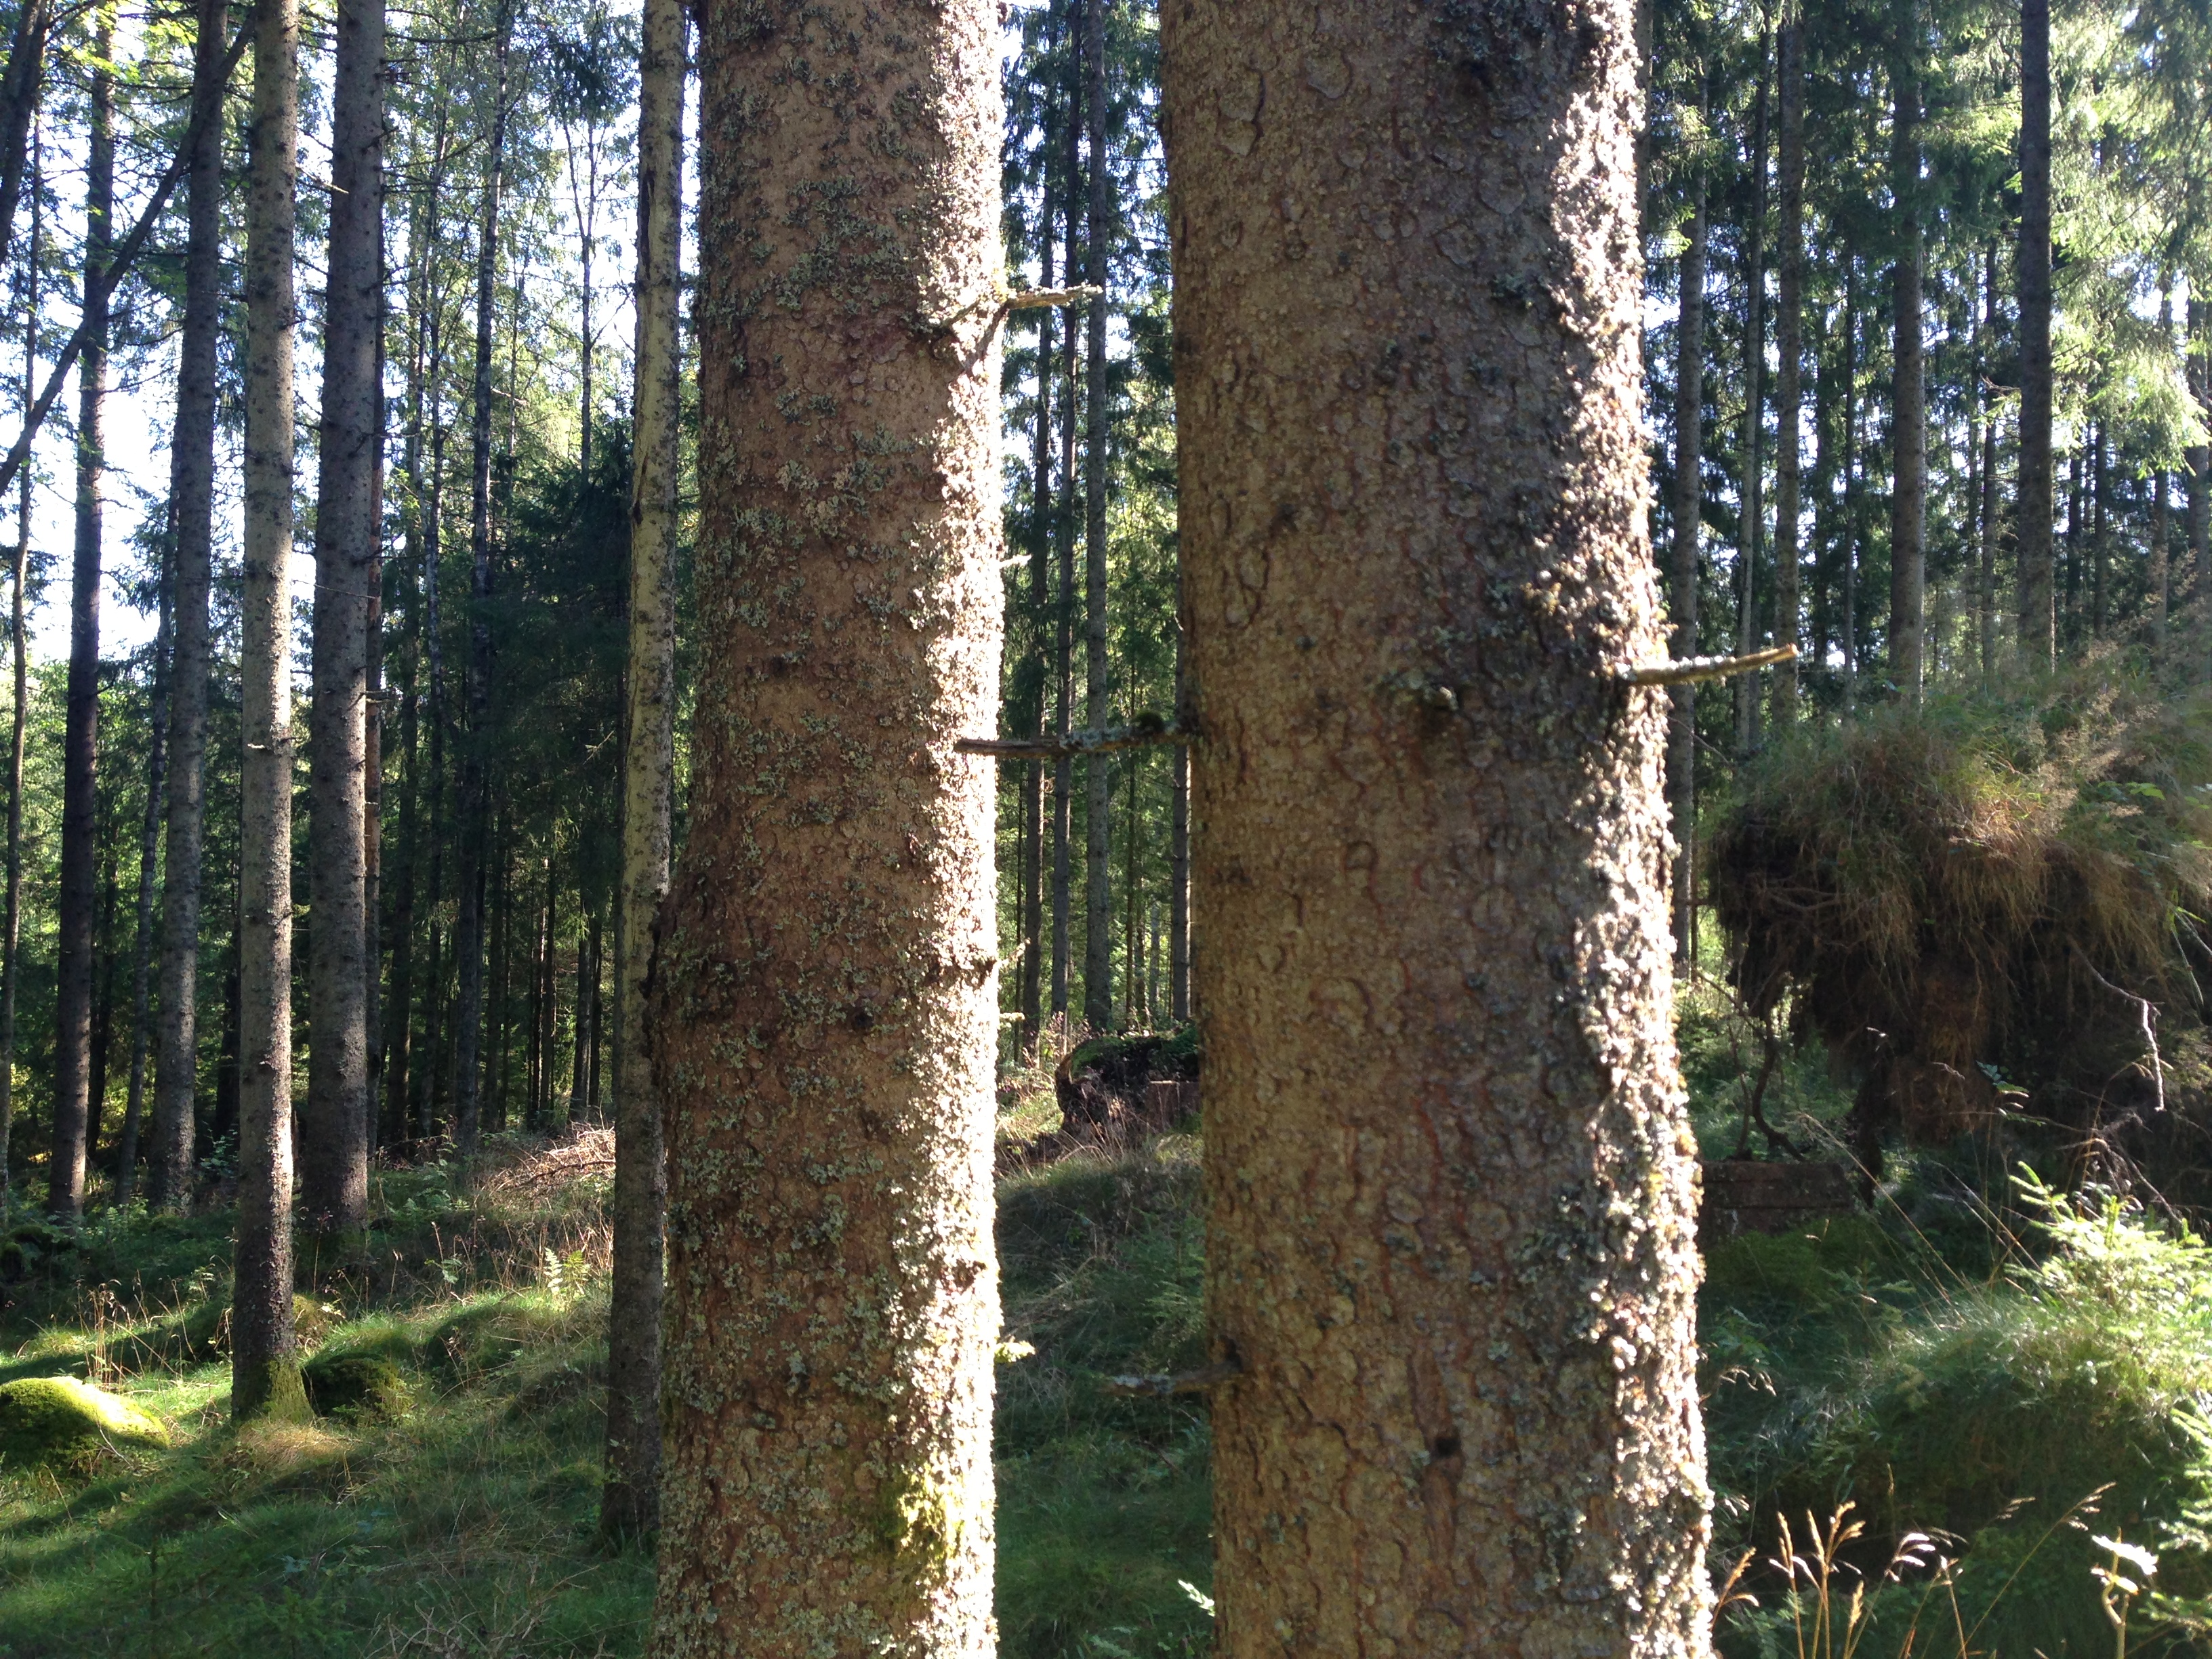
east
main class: Woodland
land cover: Spruce dominated coniferous woodland
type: boreal forest
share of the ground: 50 - 75 %
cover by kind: coniferous forest trees 70 %, shrubs 15 %, herbaceous plants 15 %
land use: Forestry
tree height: > 5 m
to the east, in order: Spruce dominated coniferous woodland; Spruce dominated mixed woodland; Spruce dominated coniferous woodland; Tracks; Spruce dominated coniferous woodland
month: September
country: SE
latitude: 57.2081
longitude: 13.2575
